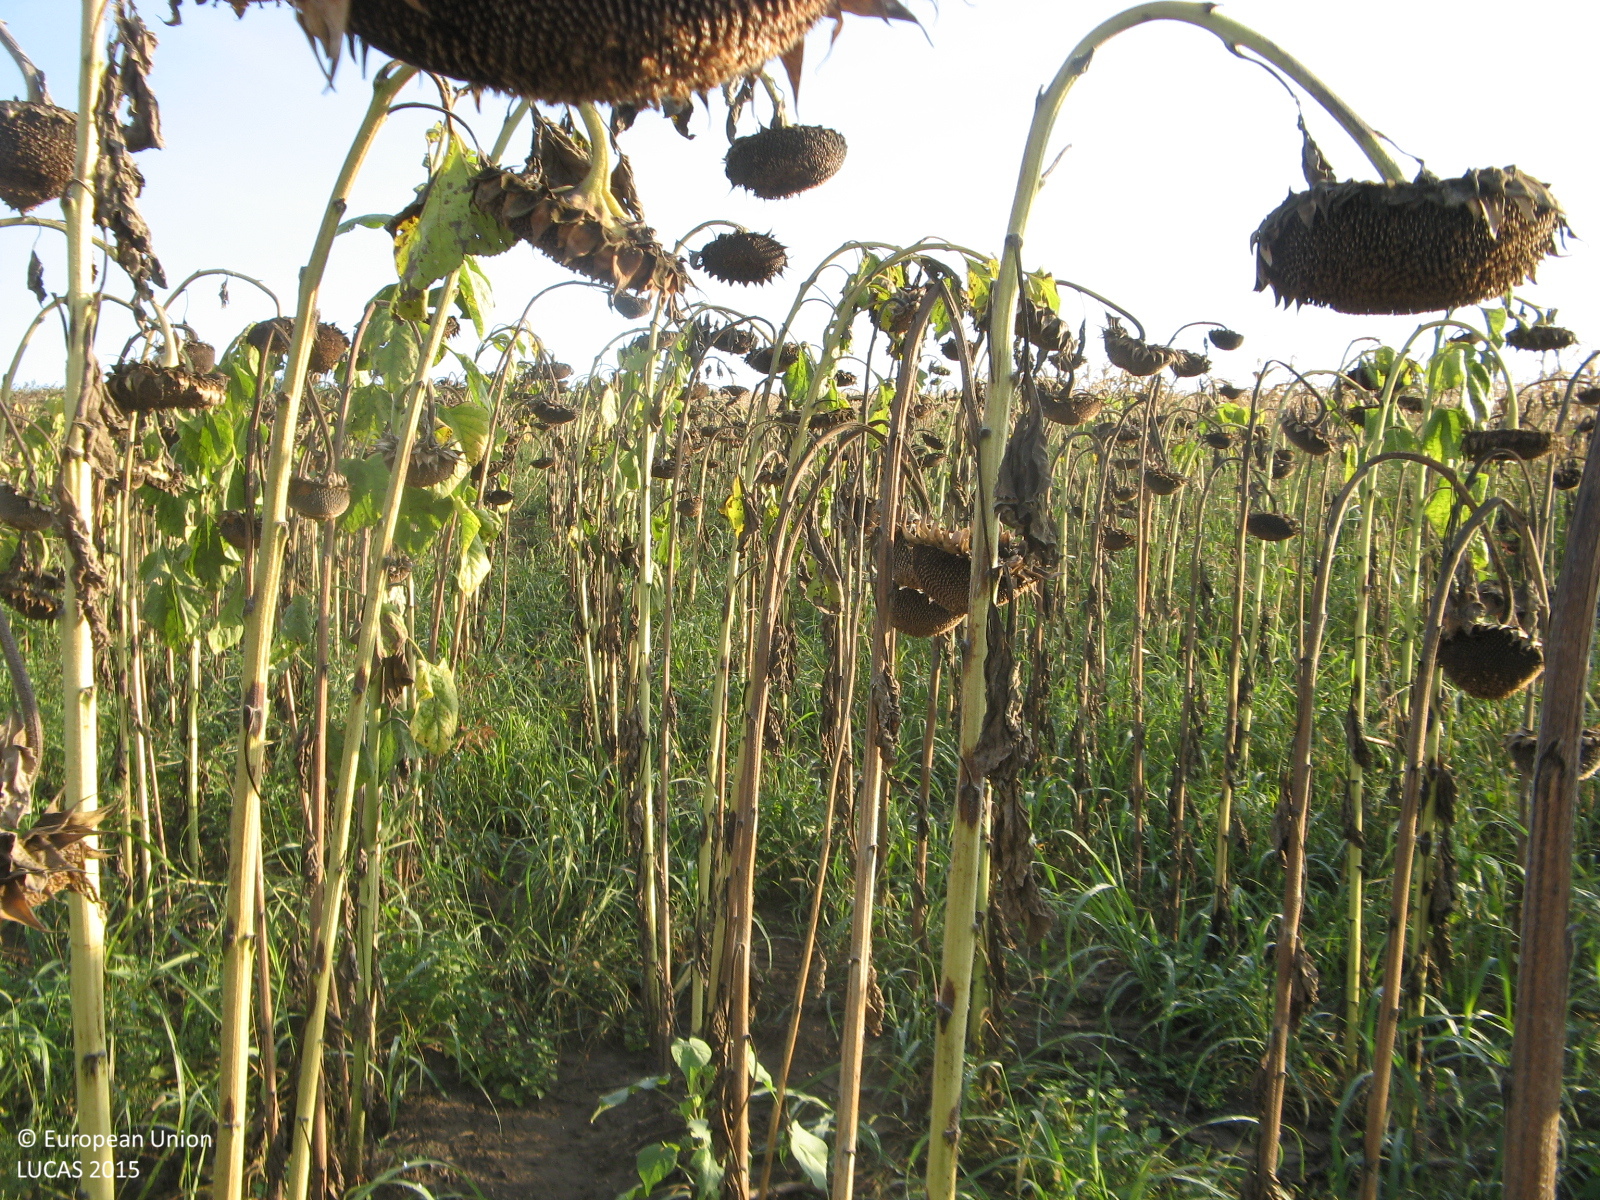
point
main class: Cropland
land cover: Sunflower
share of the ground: 50 - 75 %
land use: Agriculture (excluding fallow land and kitchen gardens)
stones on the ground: < 10 %
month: September
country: BG
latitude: 43.5808
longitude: 25.5005
